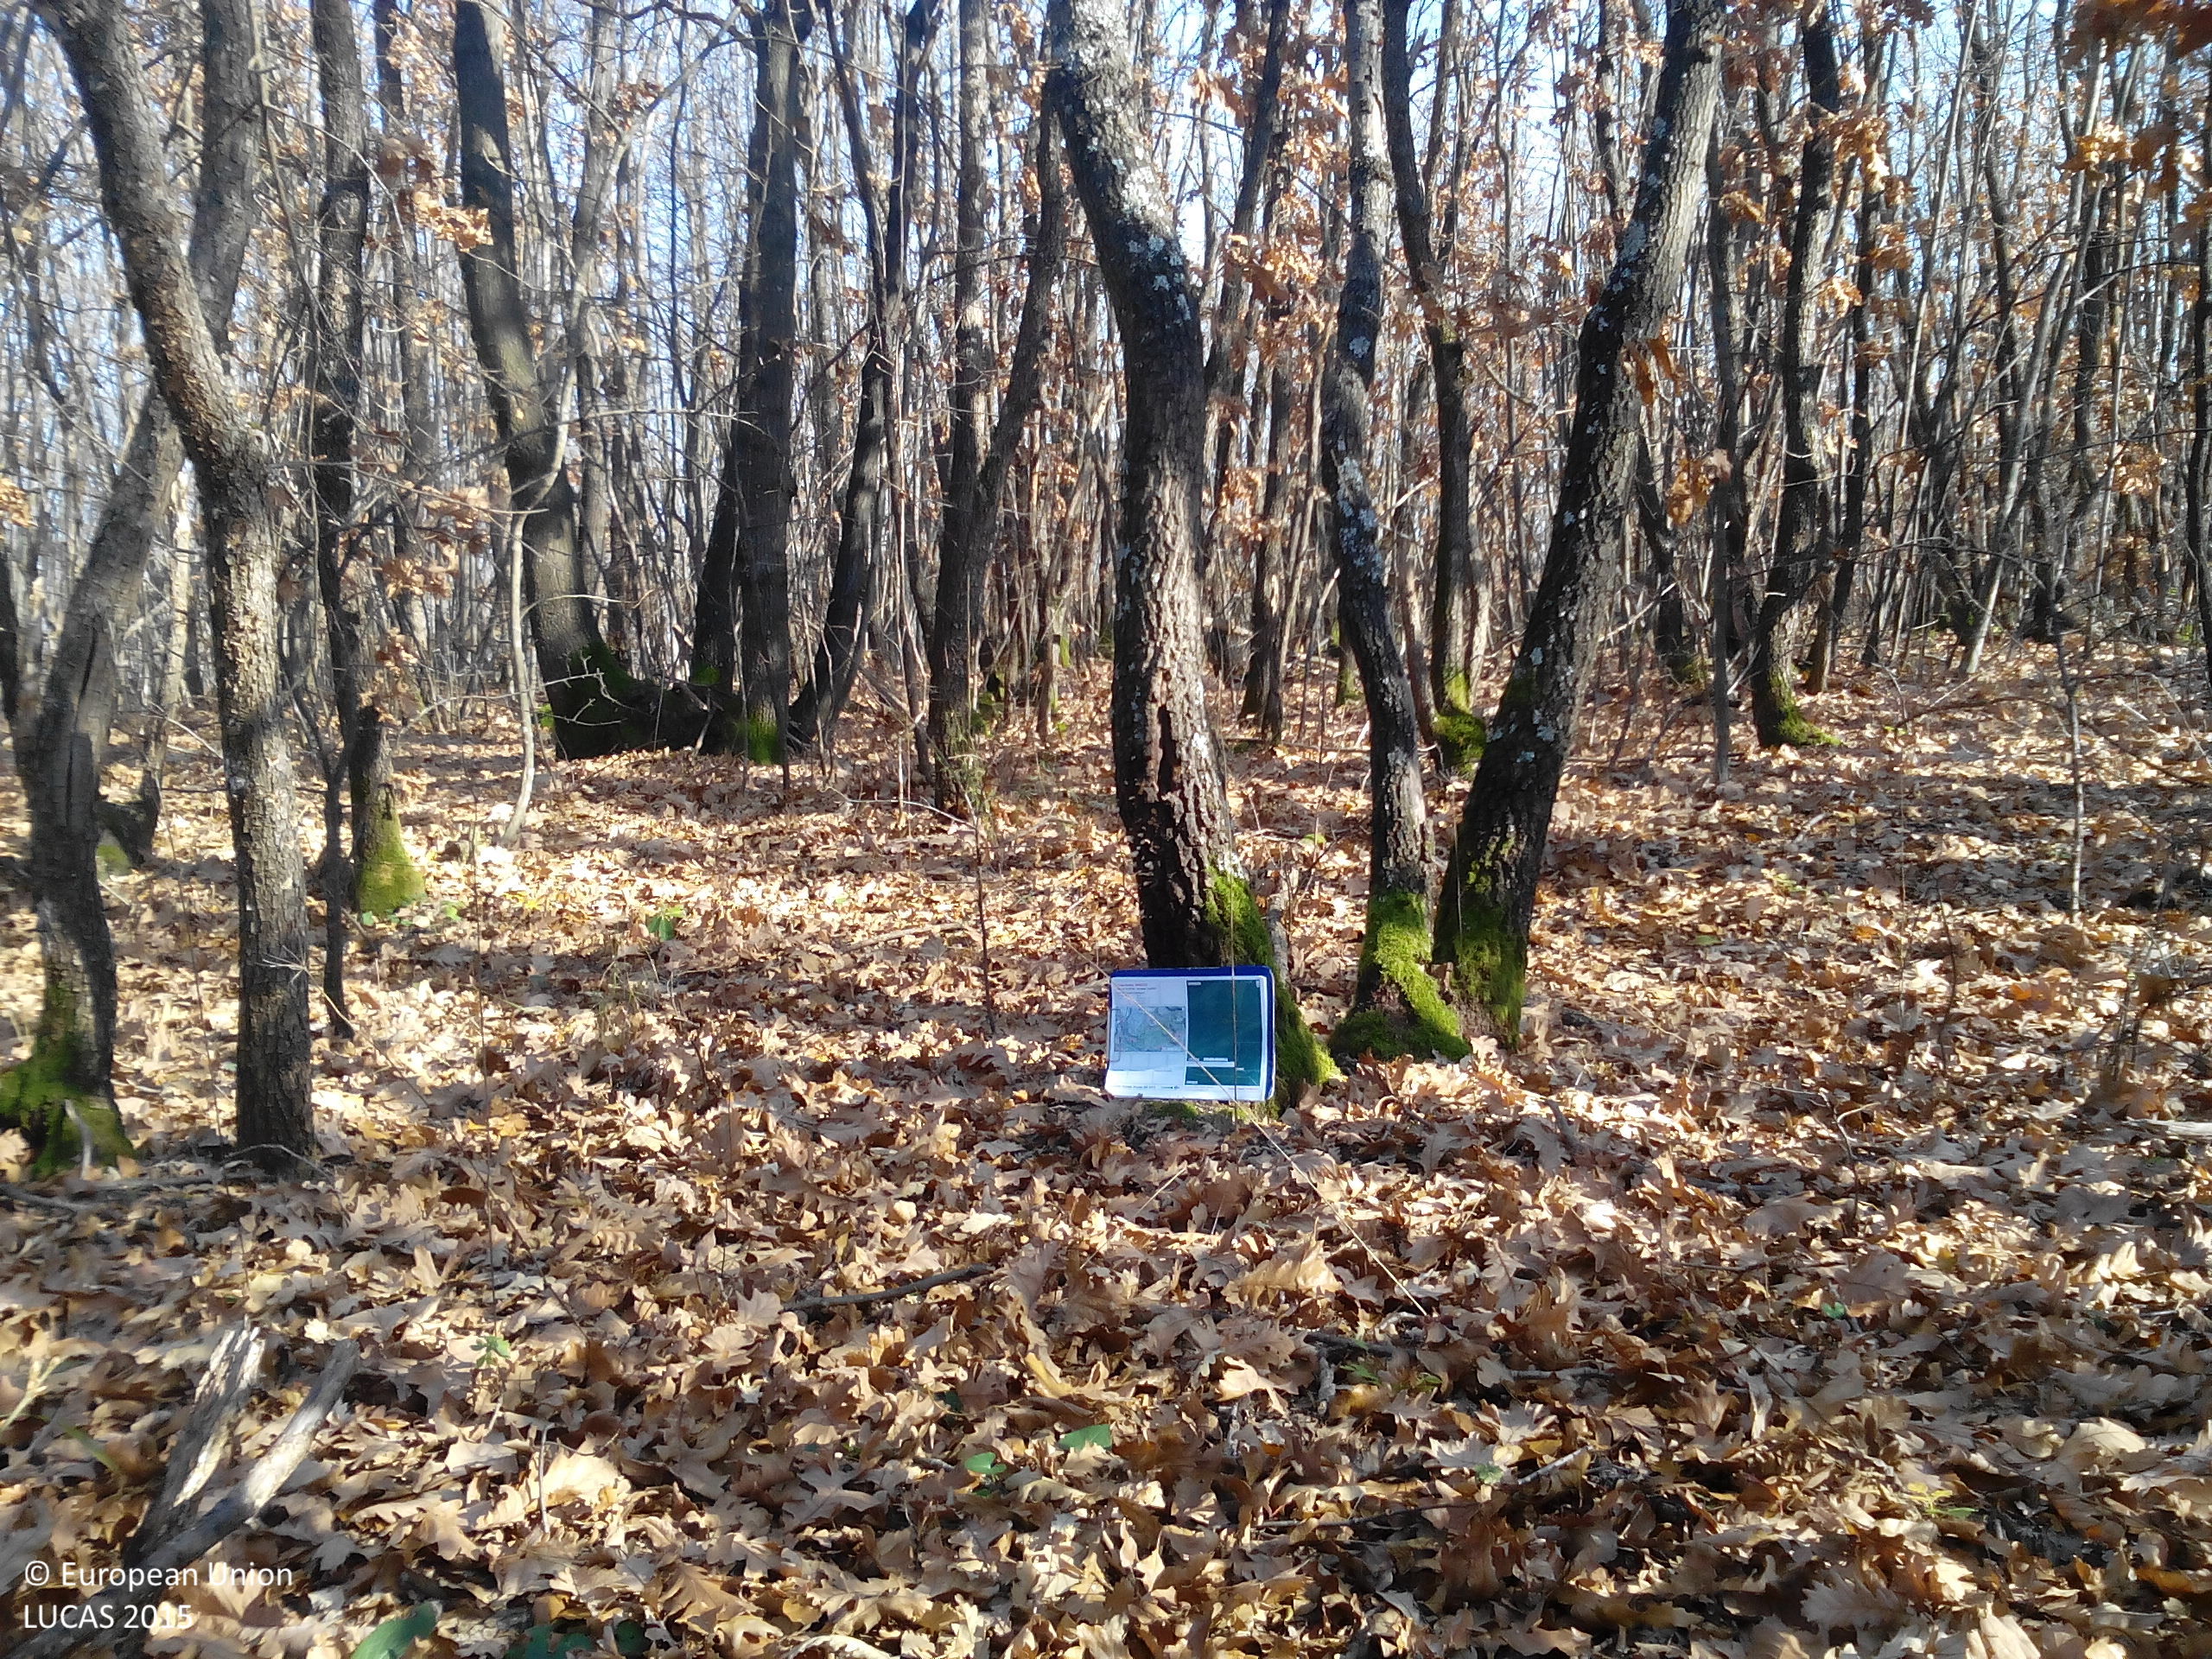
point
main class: Woodland
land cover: Broadleaved woodland
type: acidophilous oak and oak-birch forest
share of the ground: > 75 %
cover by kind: broadleaved forest trees 90 %, shrubs 5 %, herbaceous plants 5 %
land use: Forestry
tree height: > 5 m
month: November
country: BG
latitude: 43.1572
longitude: 24.0079
